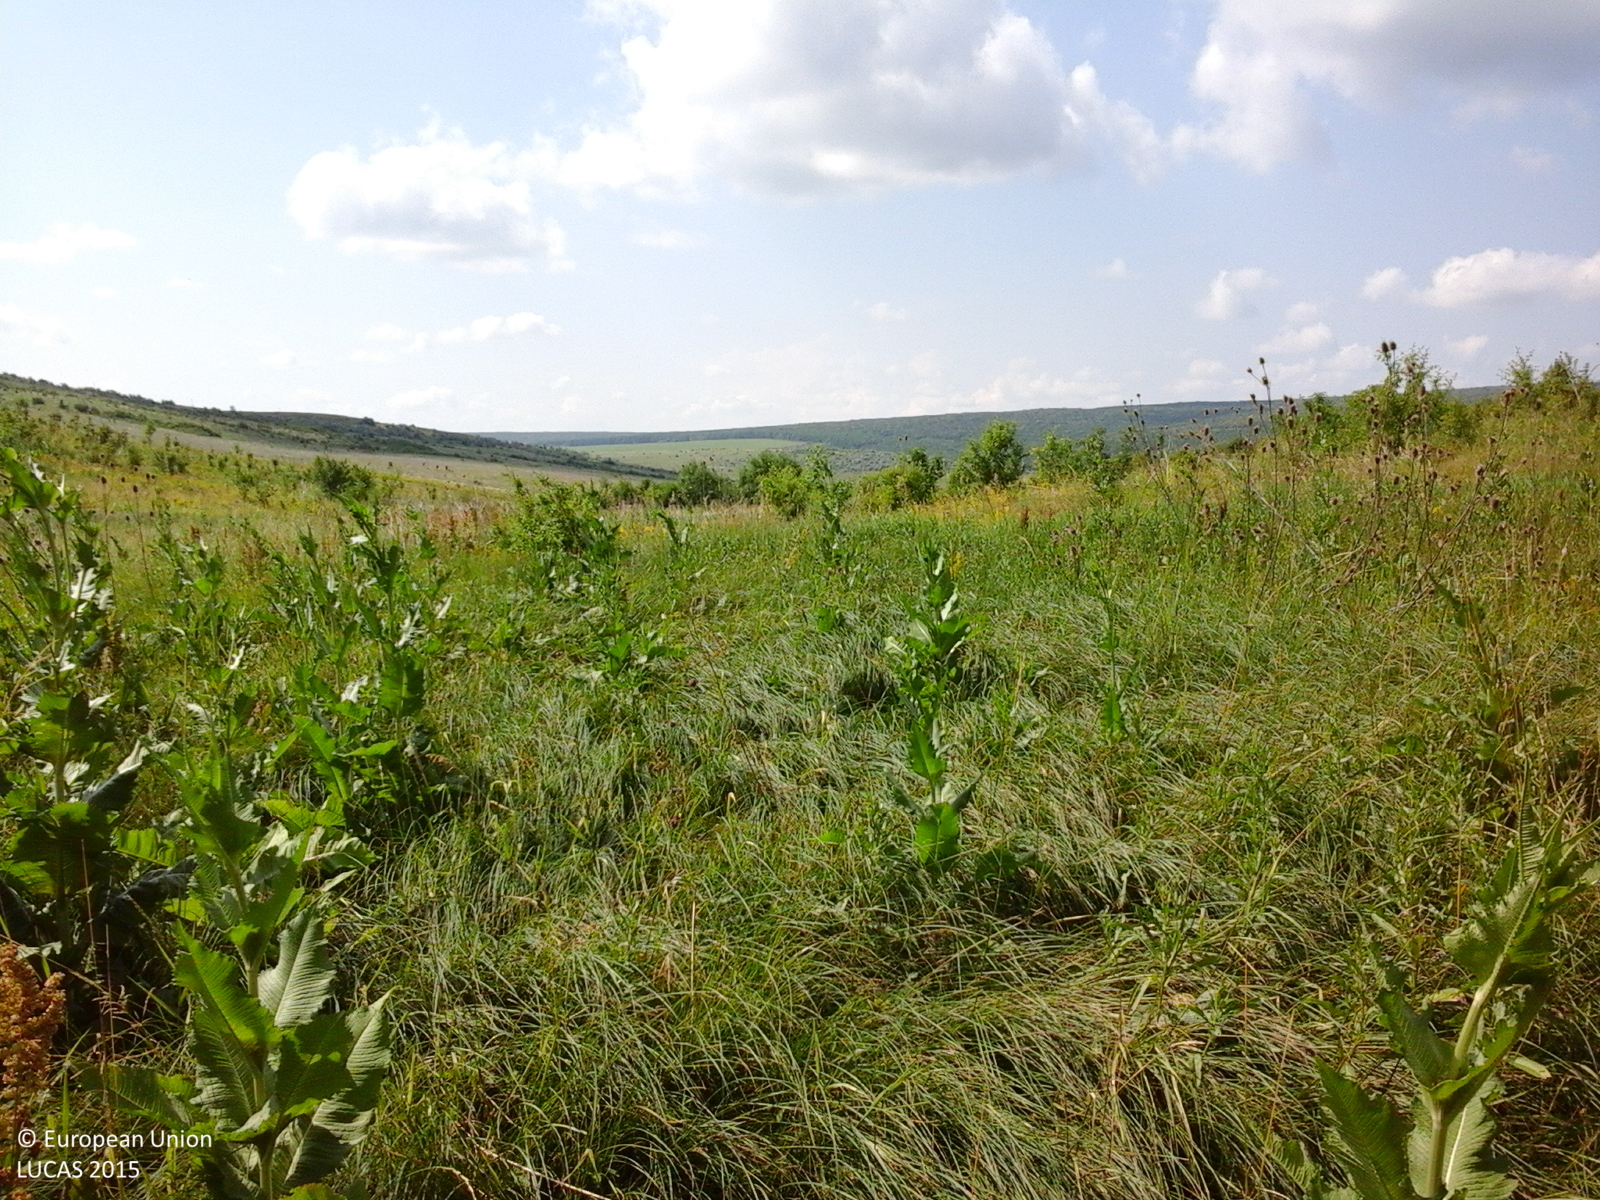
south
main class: Grassland
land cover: Grassland without tree/shrub cover
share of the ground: > 75 %
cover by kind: herbaceous plants 100 %
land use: Agriculture (excluding fallow land and kitchen gardens)
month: June
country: RO
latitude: 47.7226
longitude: 26.9680
